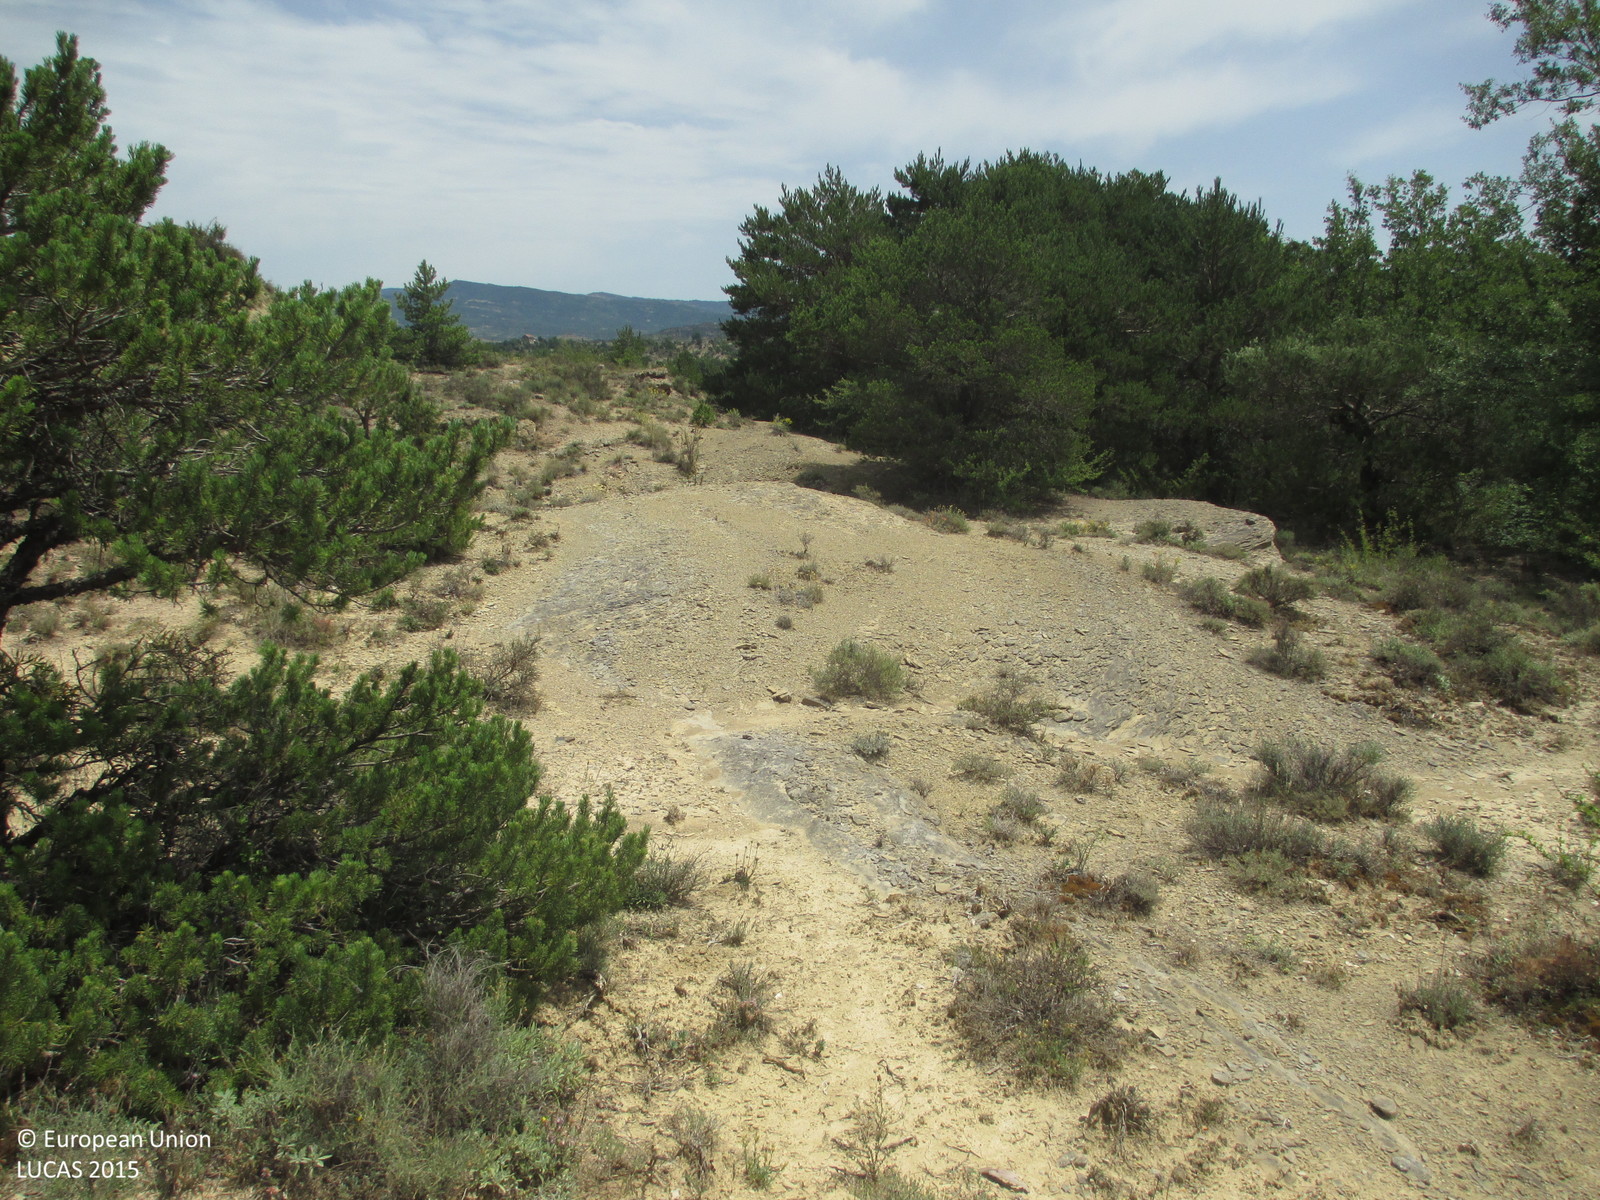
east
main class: Grassland
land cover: Grassland with sparse tree/shrub cover
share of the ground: > 75 %
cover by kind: herbaceous plants 85 %, coniferous forest trees 5 %, shrubs 5 %, unconsolidated bare surface 5 %
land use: Semi-natural and natural areas not in use
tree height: < 5 m
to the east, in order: Grassland with sparse tree/shrub cover; Shrubland with sparse tree cover; Rivers and streams; Fences; Mixed cereals for fodder
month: July
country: ES
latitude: 42.4248
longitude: -0.4166
